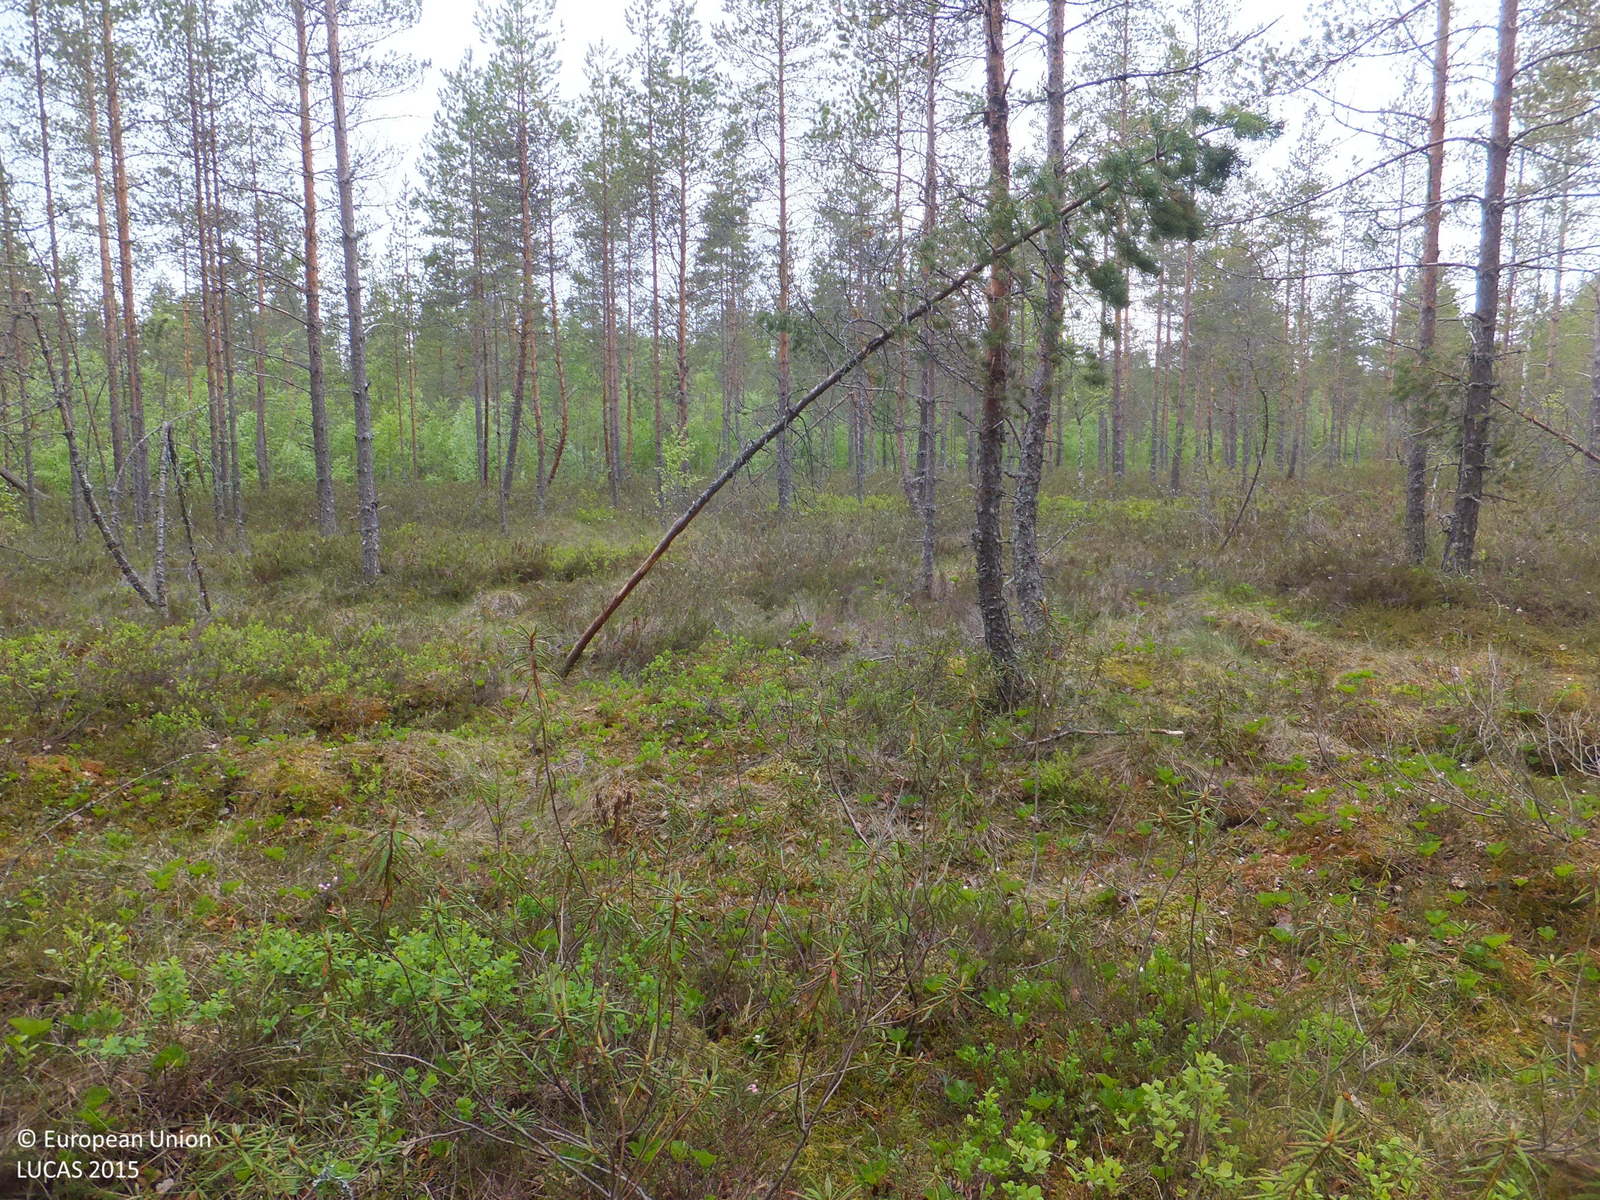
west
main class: Woodland
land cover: Pine dominated coniferous woodland
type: mire and swamp forests
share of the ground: > 75 %
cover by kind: coniferous forest trees 75 %, shrubs 15 %, herbaceous plants 10 %
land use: Forestry
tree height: > 5 m
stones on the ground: 10 - 25 %
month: June
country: FI
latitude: 63.6073
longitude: 24.2078
